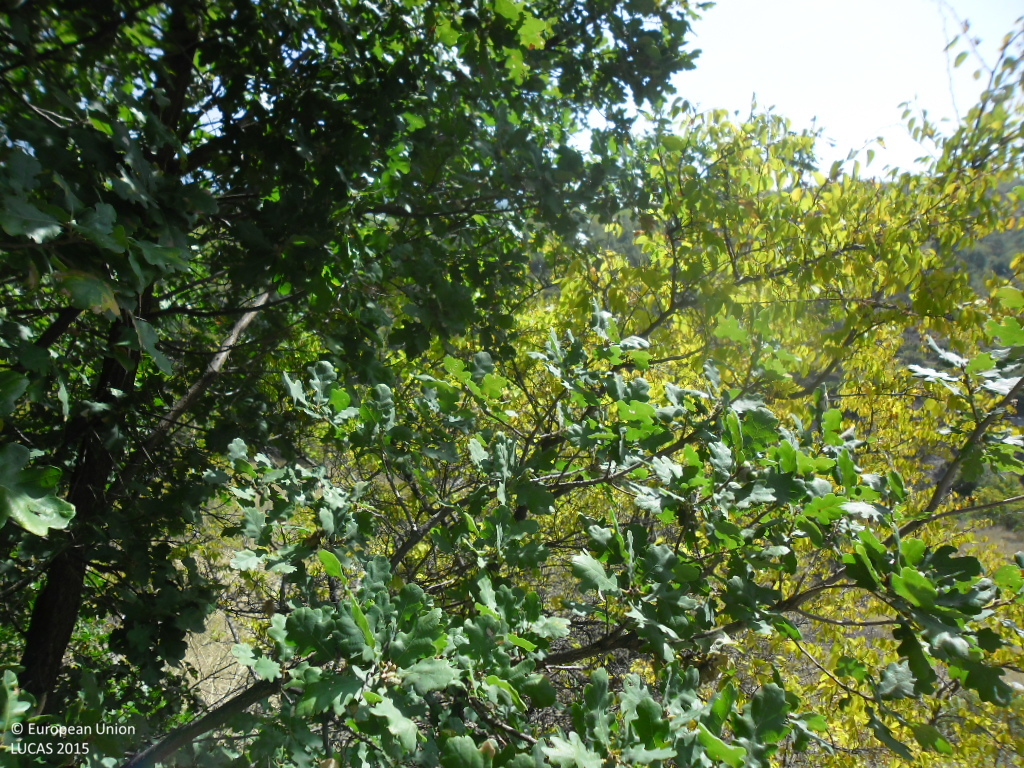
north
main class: Woodland
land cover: Broadleaved woodland
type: thermophilous deciduous forest
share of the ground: > 75 %
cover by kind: broadleaved forest trees 85 %, unconsolidated bare surface 10 %, coniferous forest trees 5 %
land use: Forestry
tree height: < 5 m
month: September
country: BG
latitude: 41.6732
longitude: 23.2230
